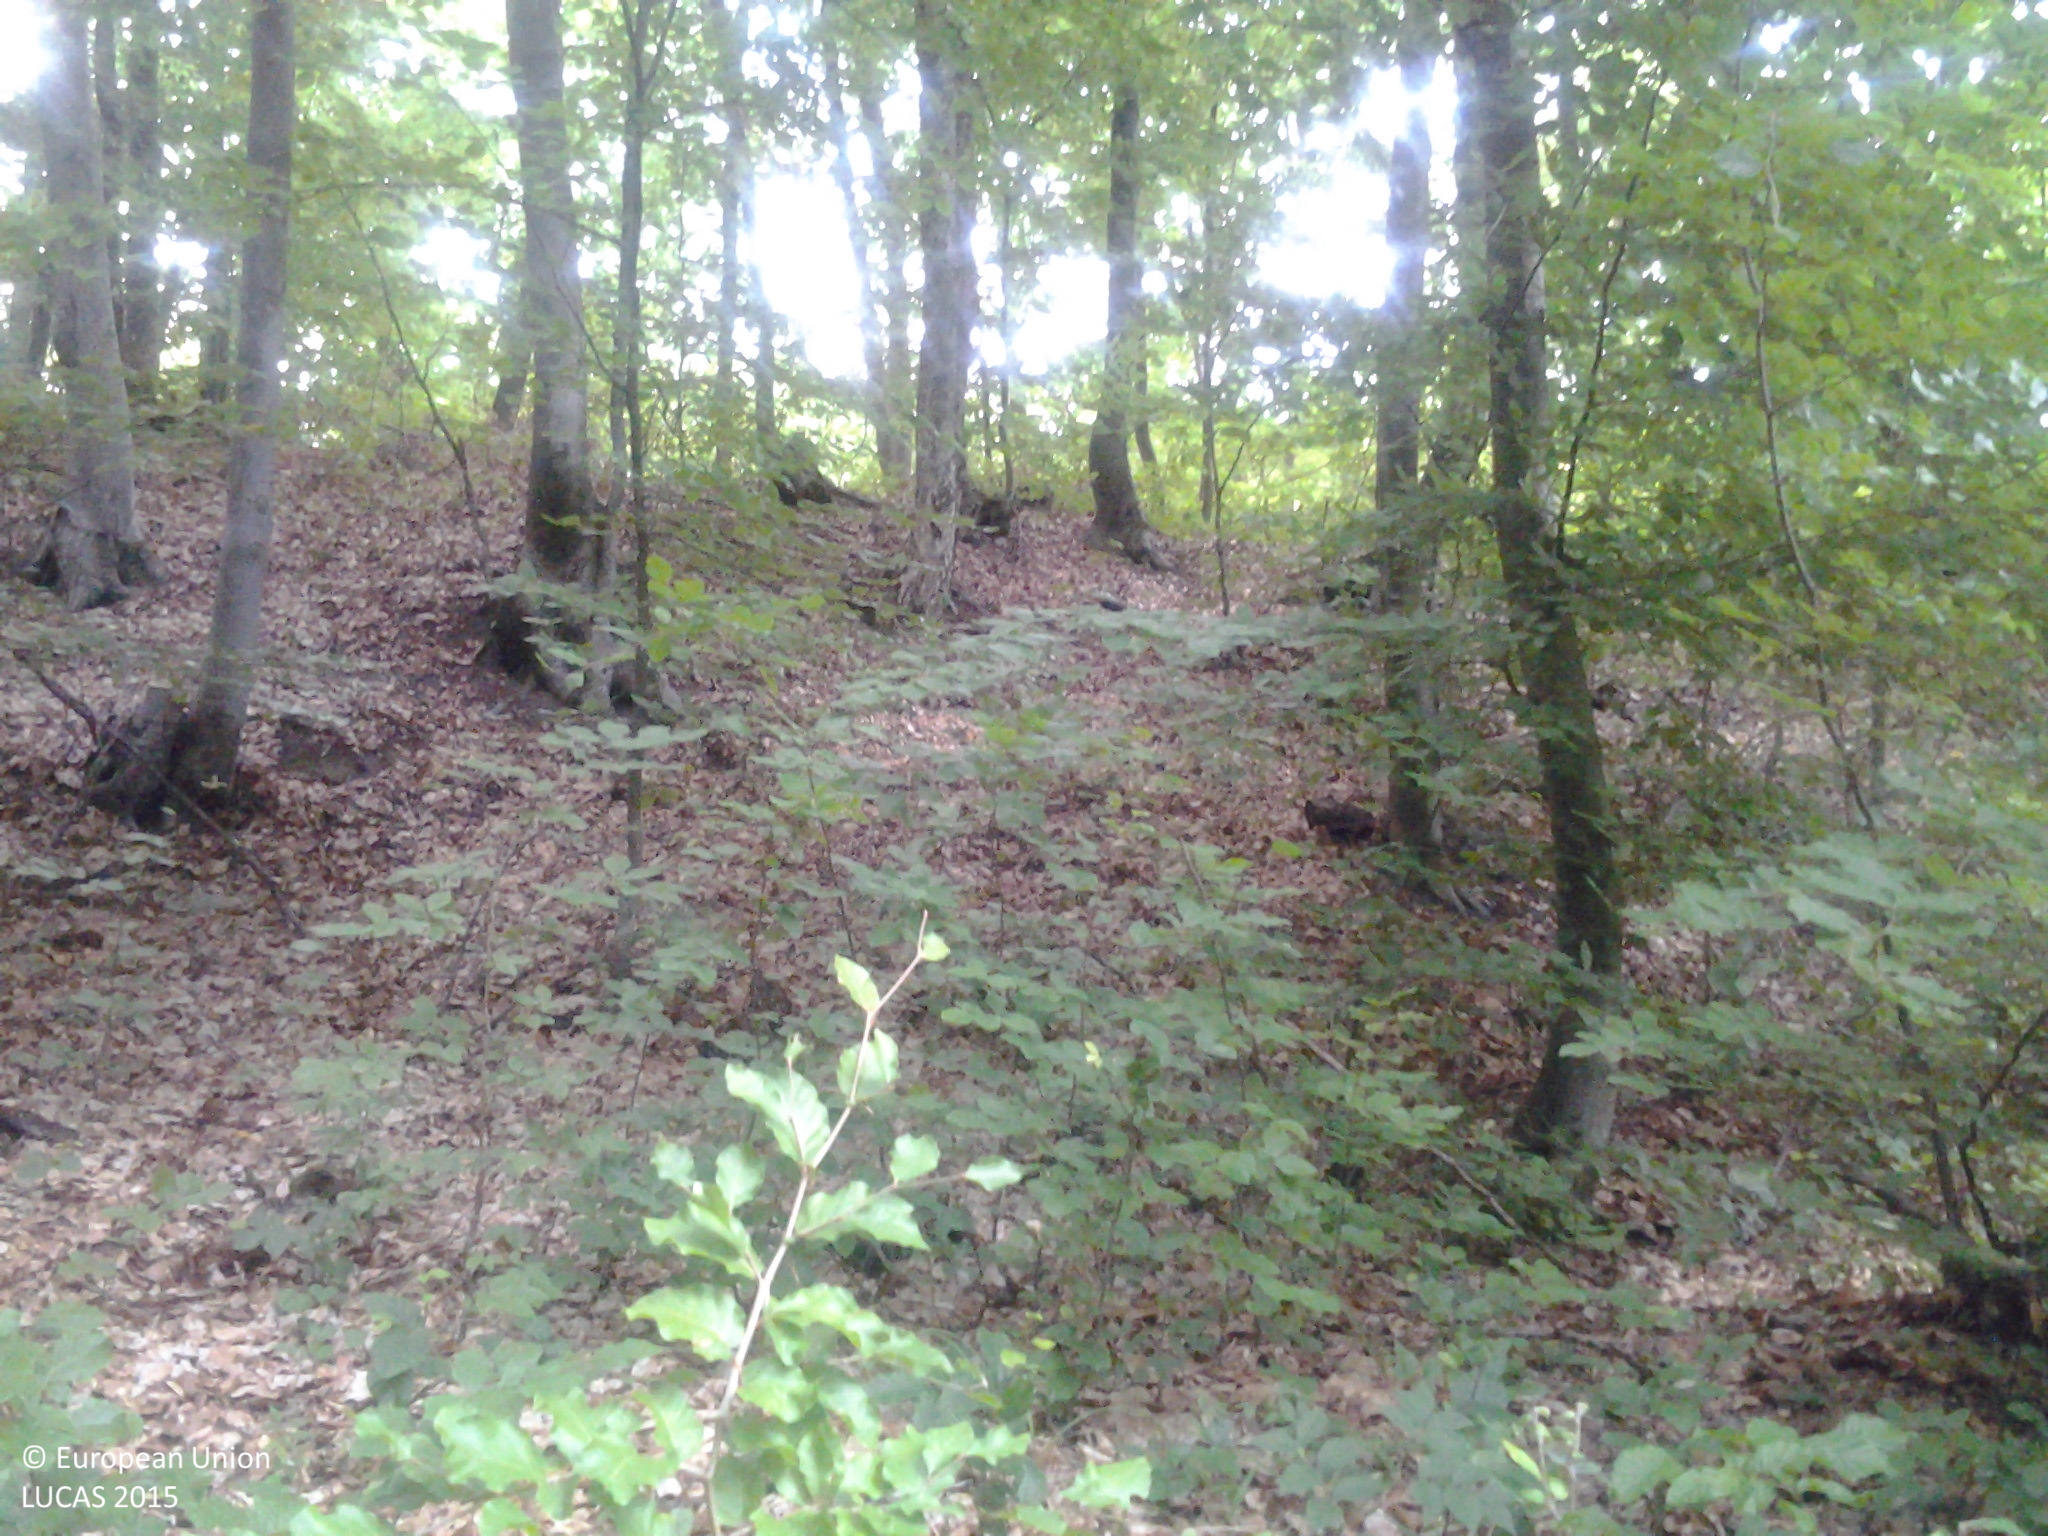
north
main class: Woodland
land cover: Broadleaved woodland
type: beech forest
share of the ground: > 75 %
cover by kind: broadleaved forest trees 100 %
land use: Forestry
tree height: > 5 m
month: June
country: RO
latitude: 46.6235
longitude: 27.1710
